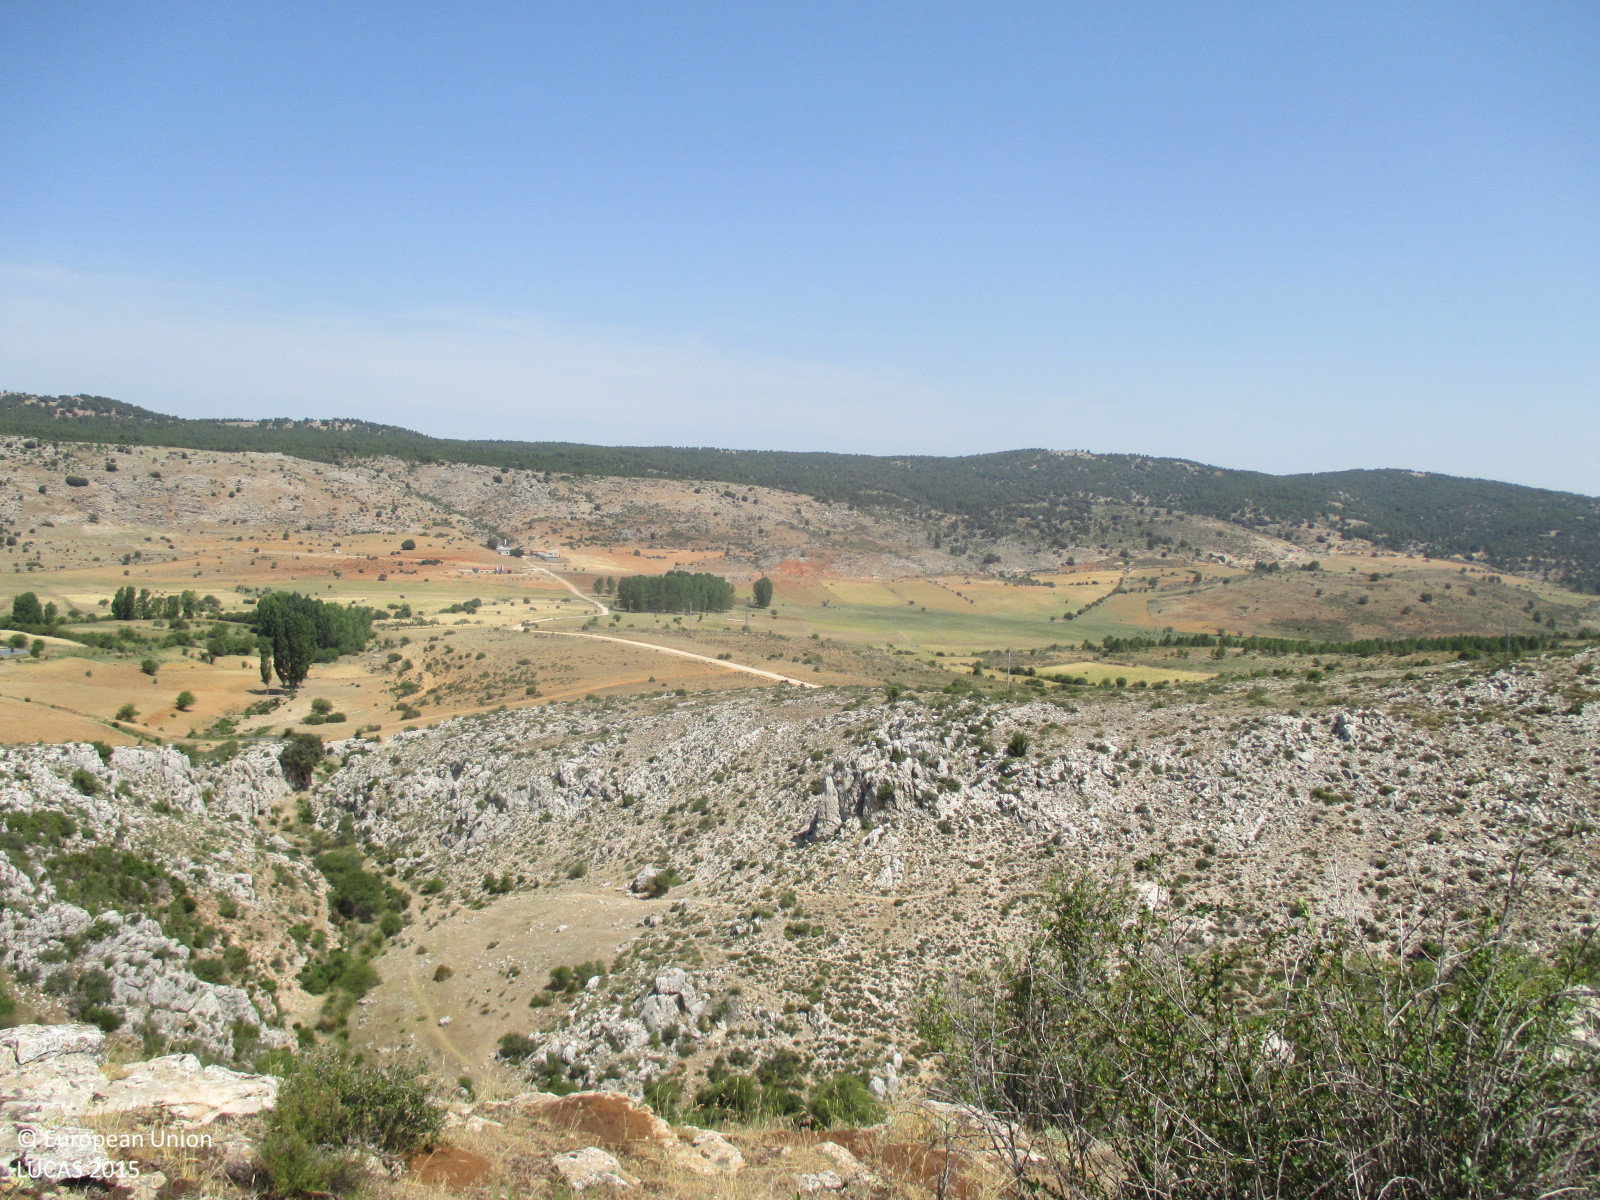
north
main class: Shrubland
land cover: Shrubland without tree cover
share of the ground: 50 - 75 %
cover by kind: shrubs 60 %, consolidated bare surface 30 %, herbaceous plants 10 %
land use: Semi-natural and natural areas not in use
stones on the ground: < 10 %
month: July
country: ES
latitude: 38.0947
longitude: -2.4793
